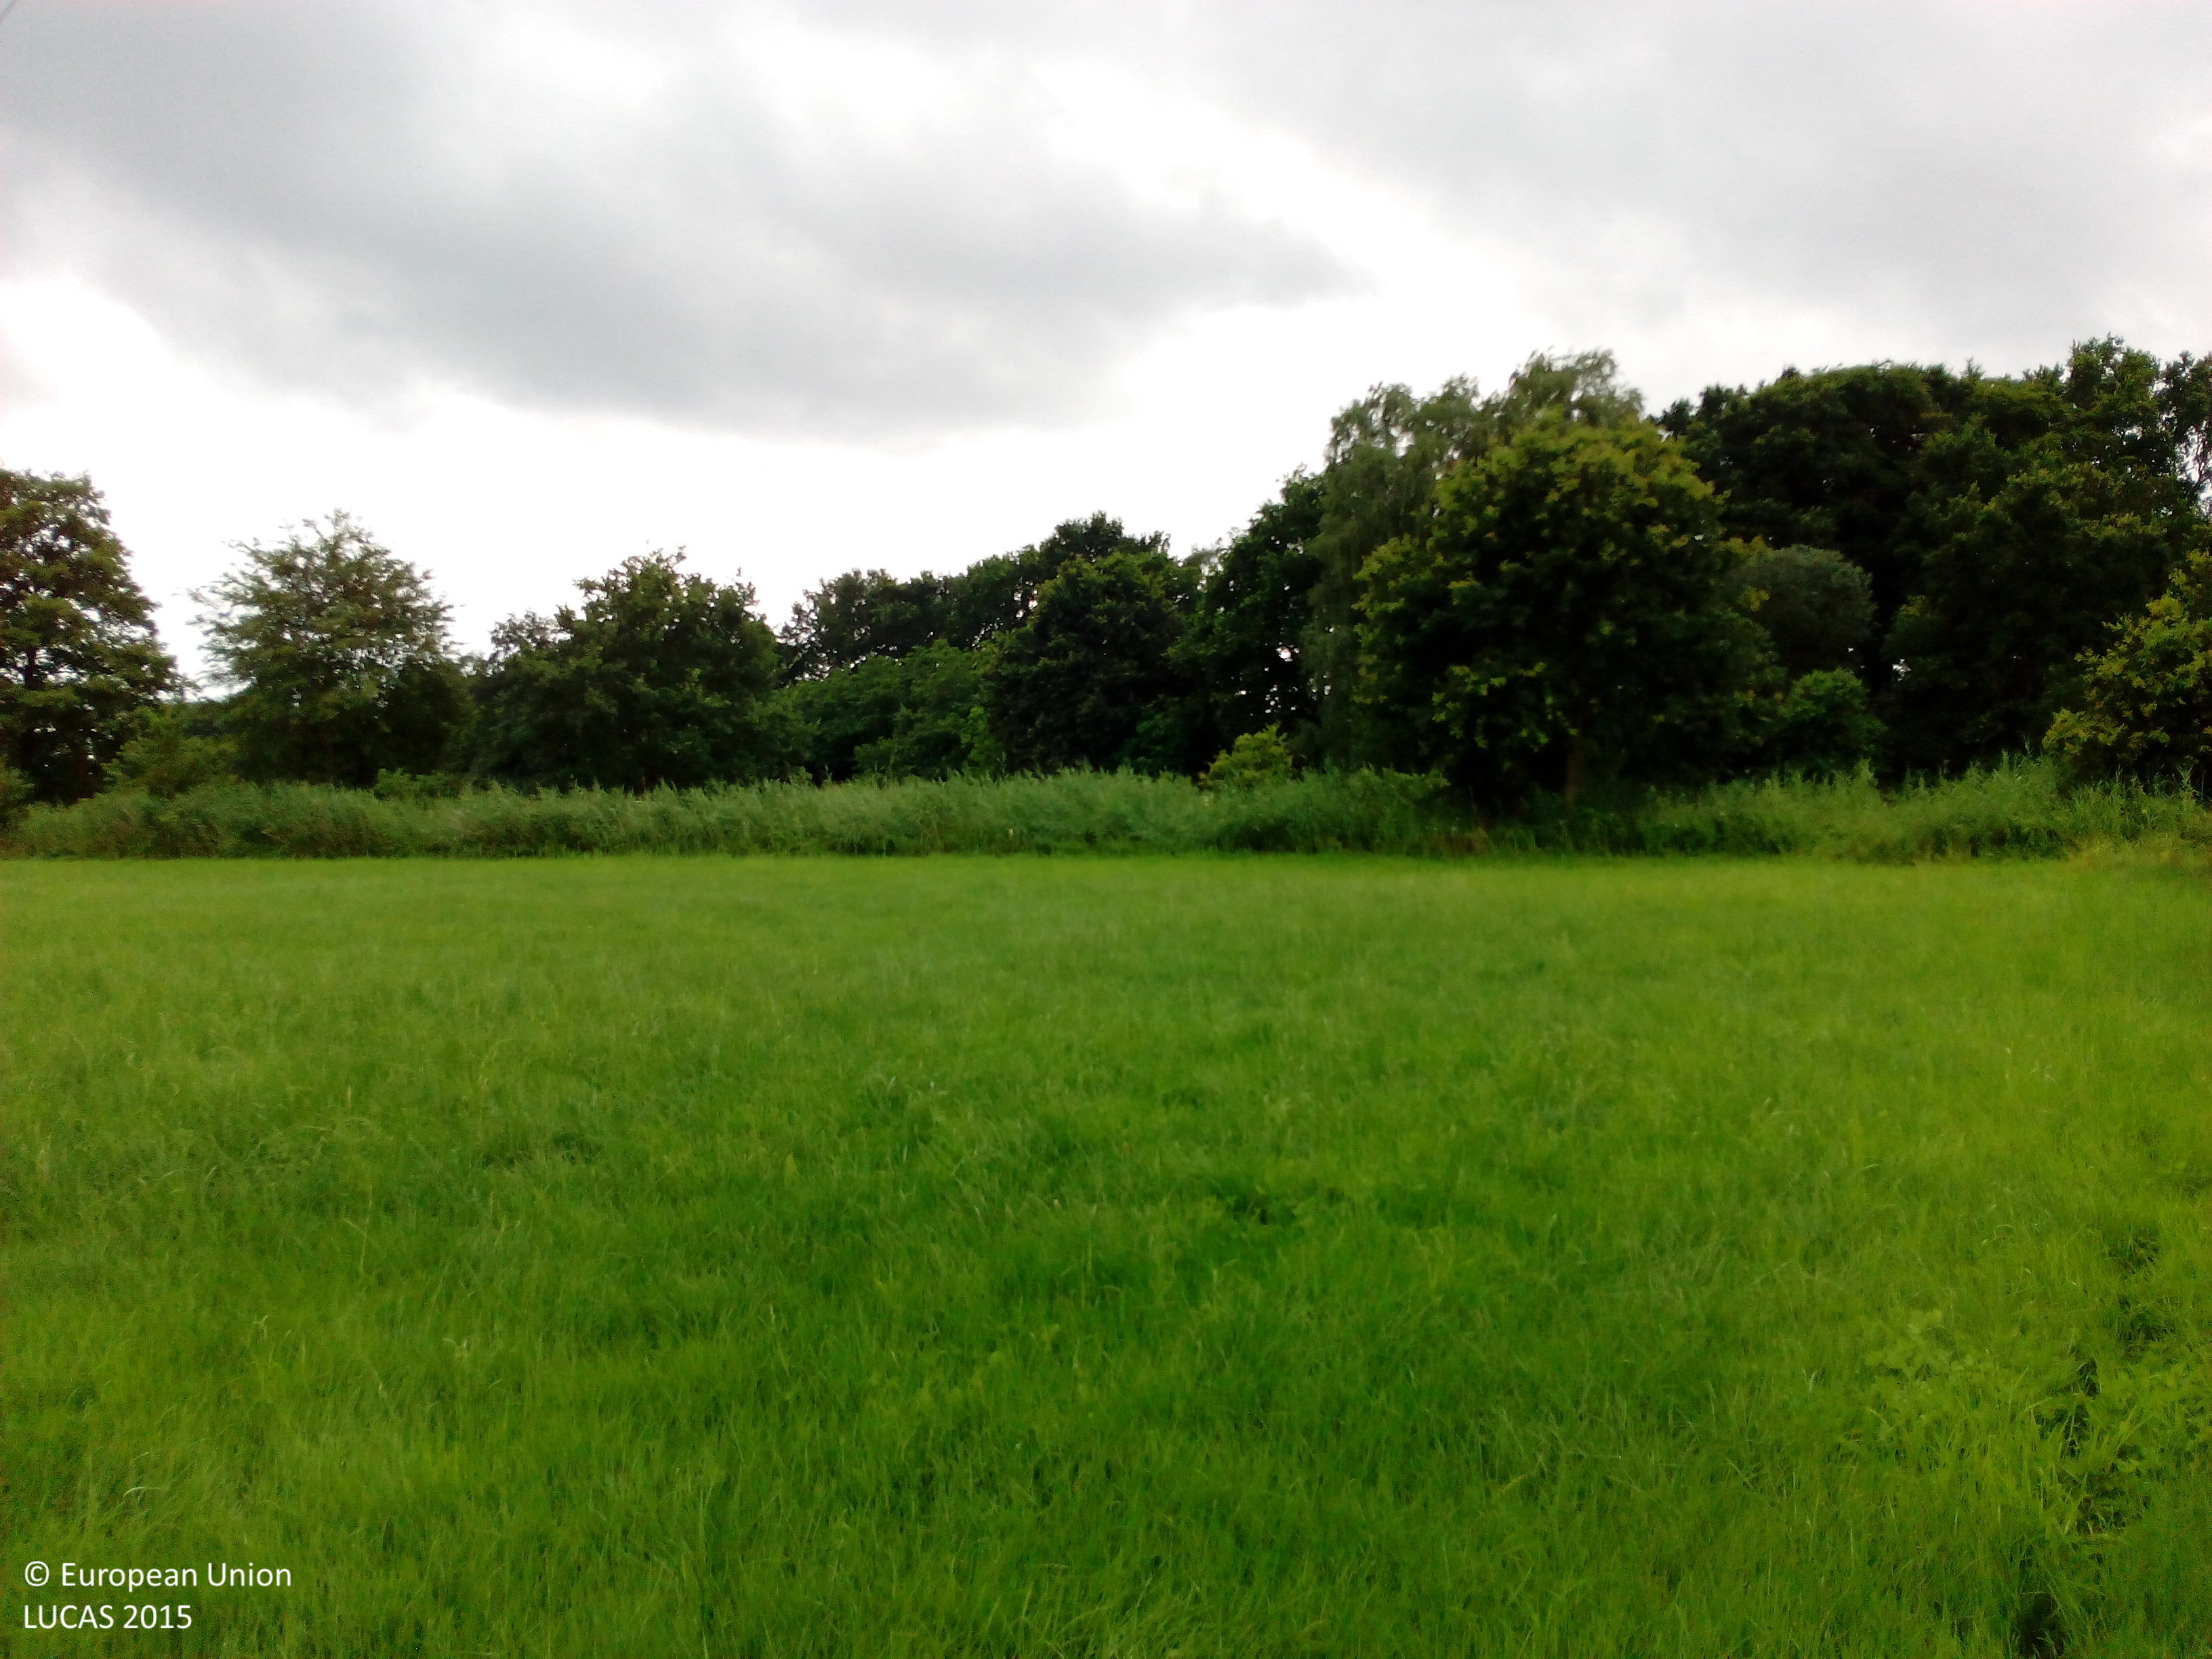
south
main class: Grassland
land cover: Grassland without tree/shrub cover
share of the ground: > 75 %
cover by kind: herbaceous plants 100 %
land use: Agriculture (excluding fallow land and kitchen gardens)
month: July
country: DE
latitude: 52.3240
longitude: 7.9610
